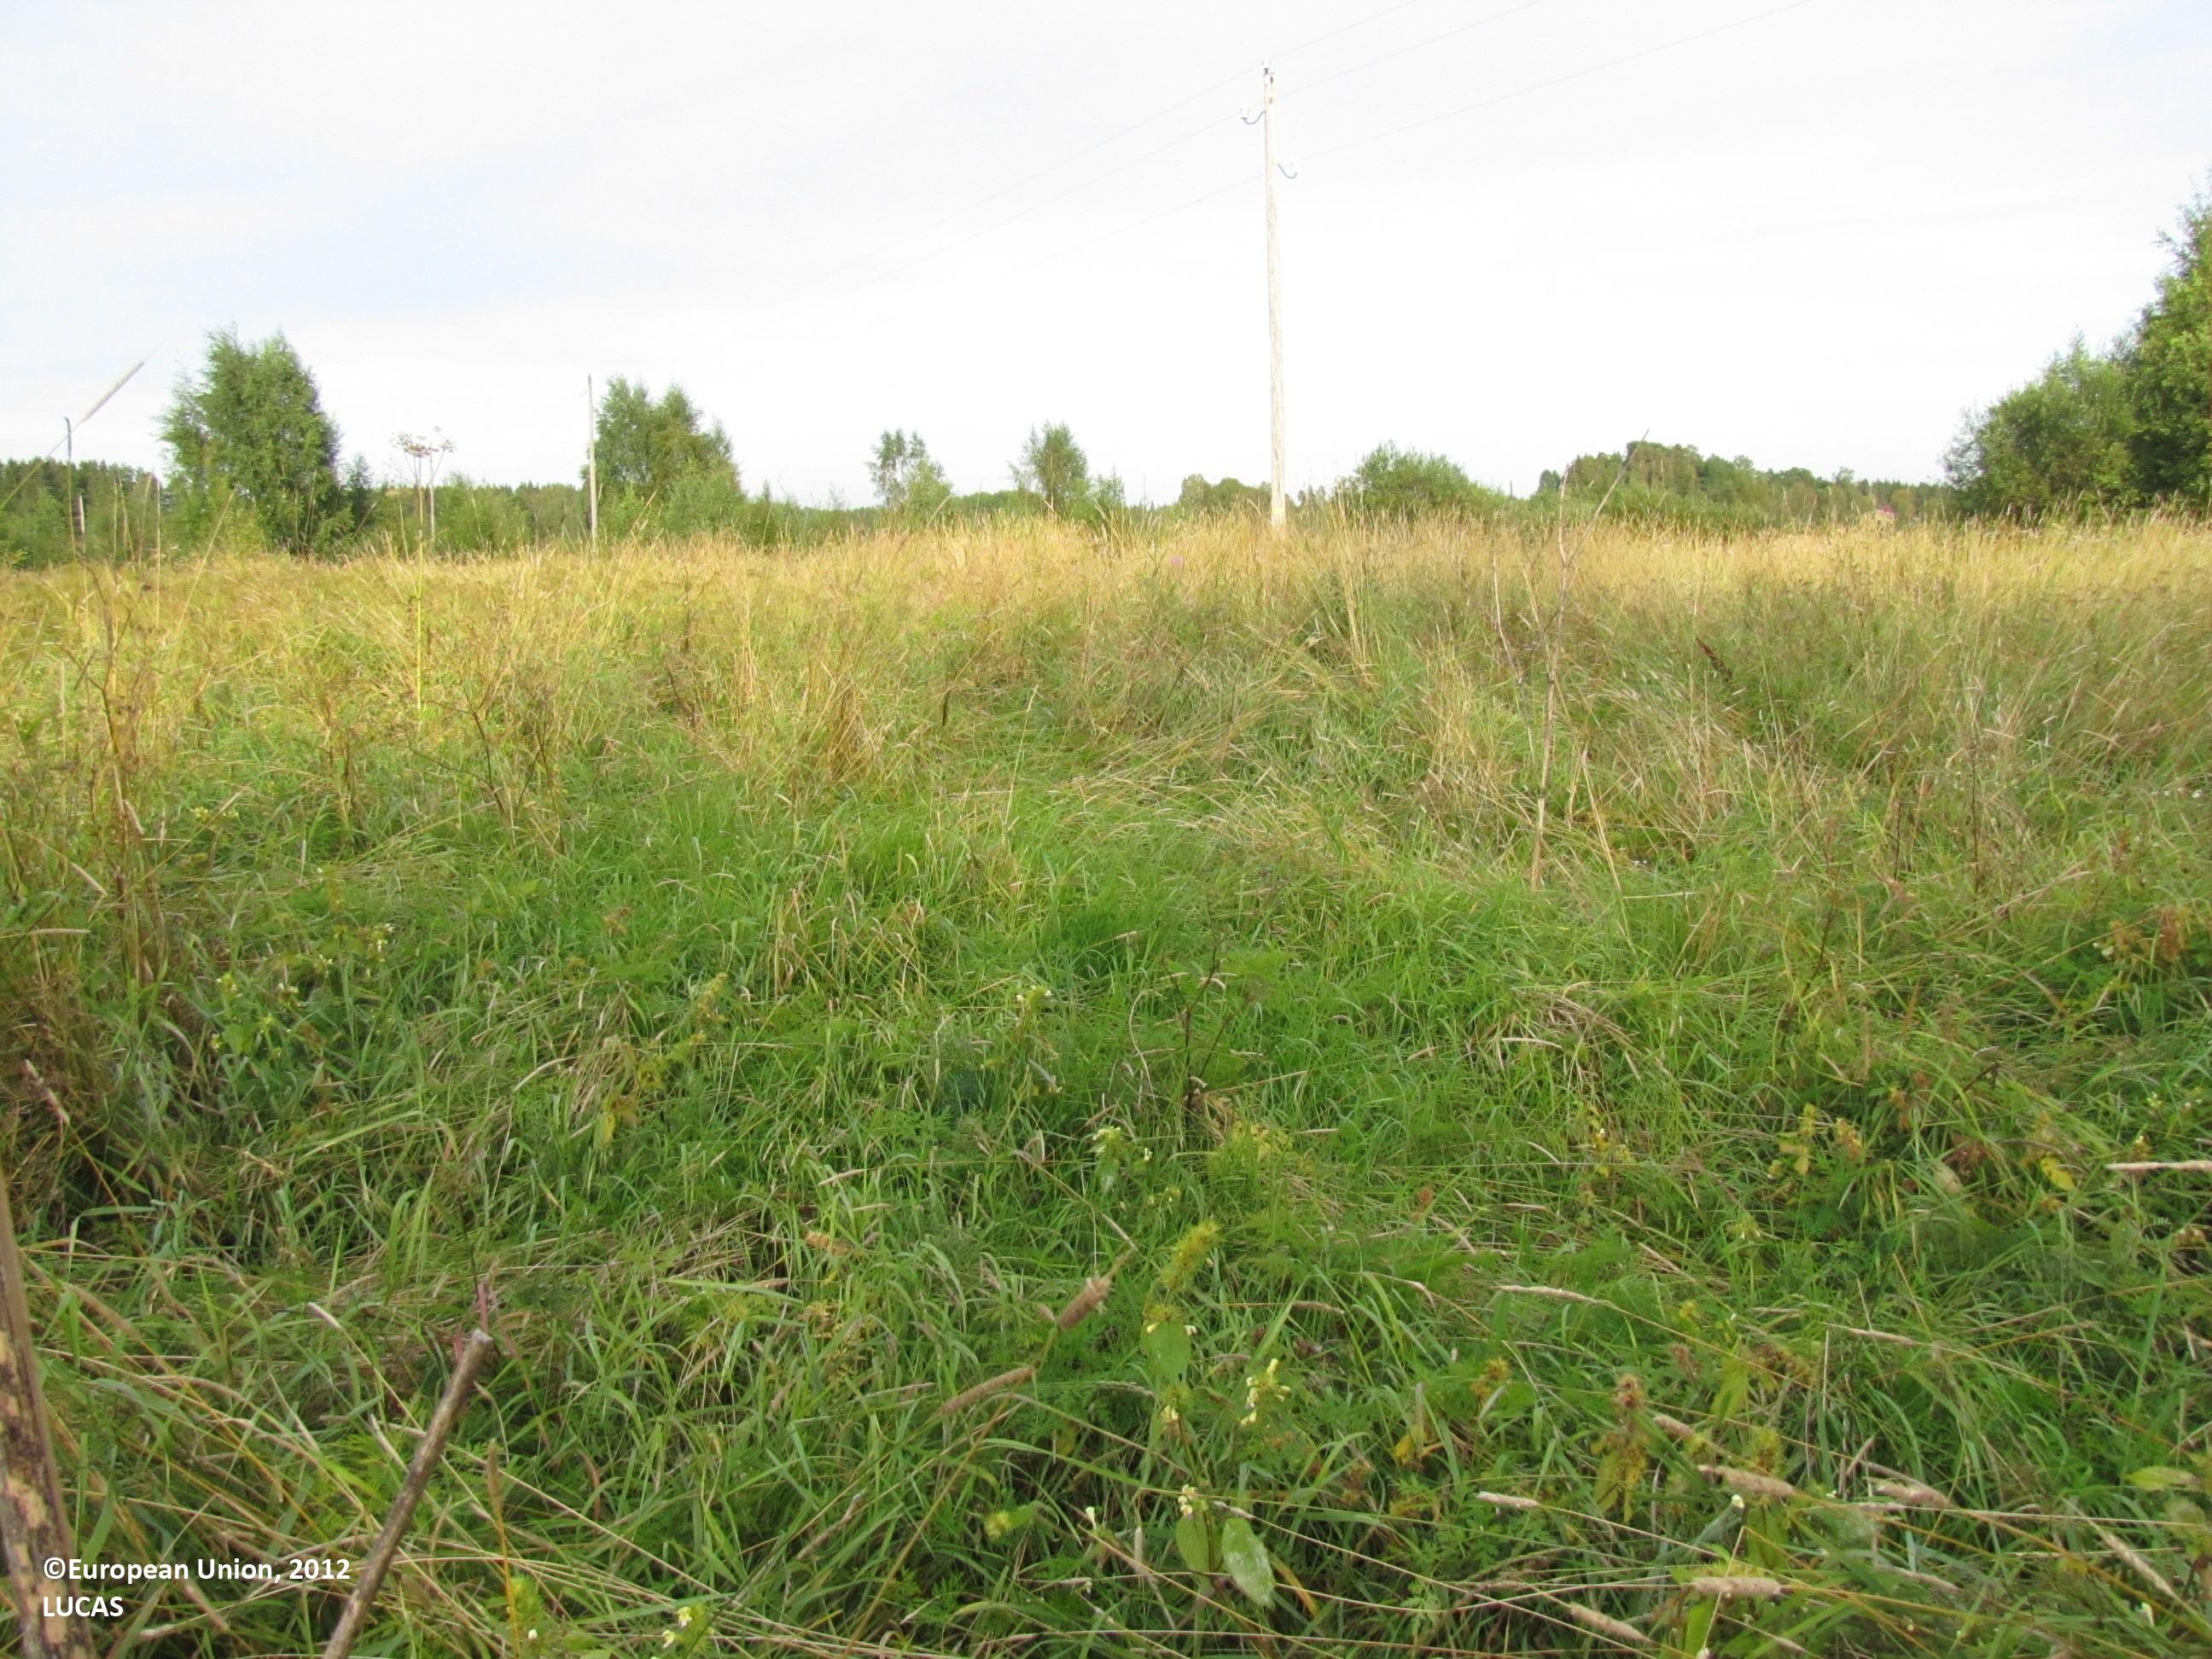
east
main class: Grassland
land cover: Grassland without tree/shrub cover
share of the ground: > 75 %
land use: Fallow land
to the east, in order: Grassland without tree/shrub cover; Ditches and canals; Grassland without tree/shrub cover; Electric lines; Grassland without tree/shrub cover; Ditches and canals; Grassland without tree/shrub cover; Abandoned hedges; Ditches and canals; Grassland with sparse tree/shrub cover; Grassland without tree/shrub cover; Ditches and canals; Grass margins; Oats
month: August
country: FI
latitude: 61.3883
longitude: 23.5785
